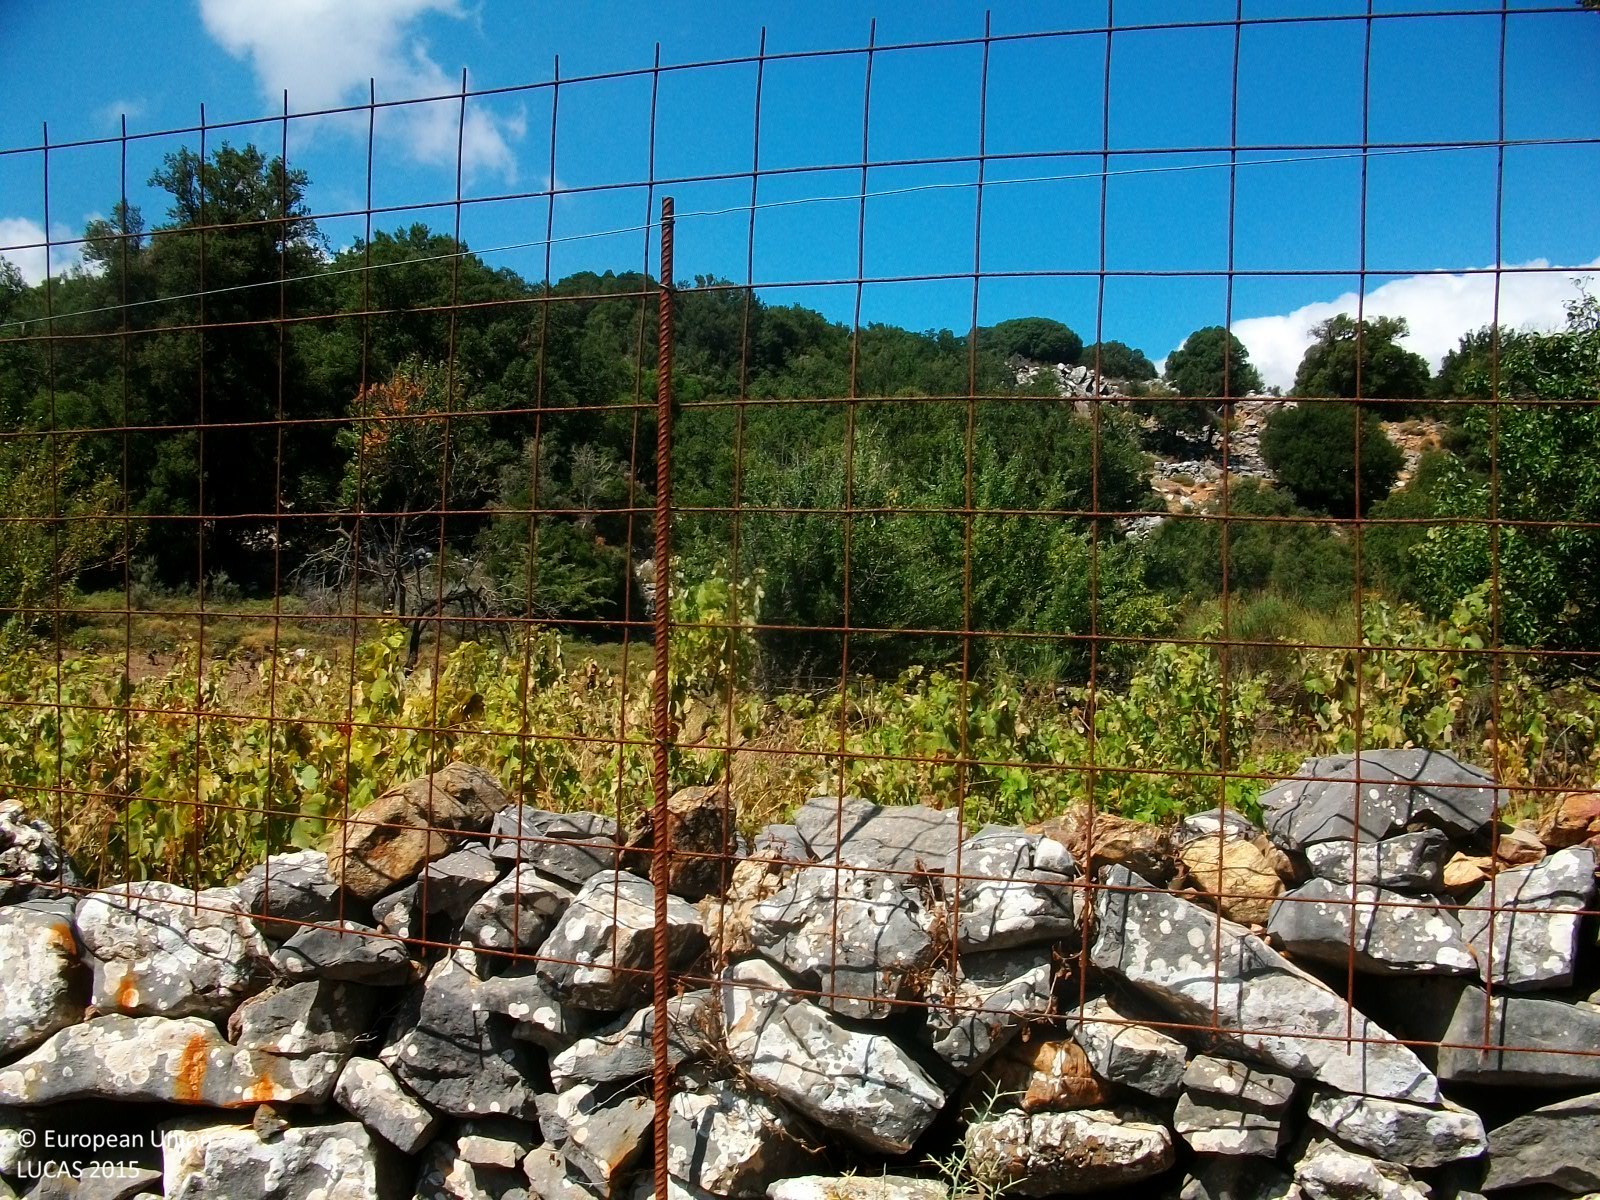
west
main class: Cropland
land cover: Vineyards
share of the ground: 50 - 75 %
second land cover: Spontaneously vegetated surfaces
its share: 50 - 75 %
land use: Agriculture (excluding fallow land and kitchen gardens)
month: August
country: GR
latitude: 35.2077
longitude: 25.5386
